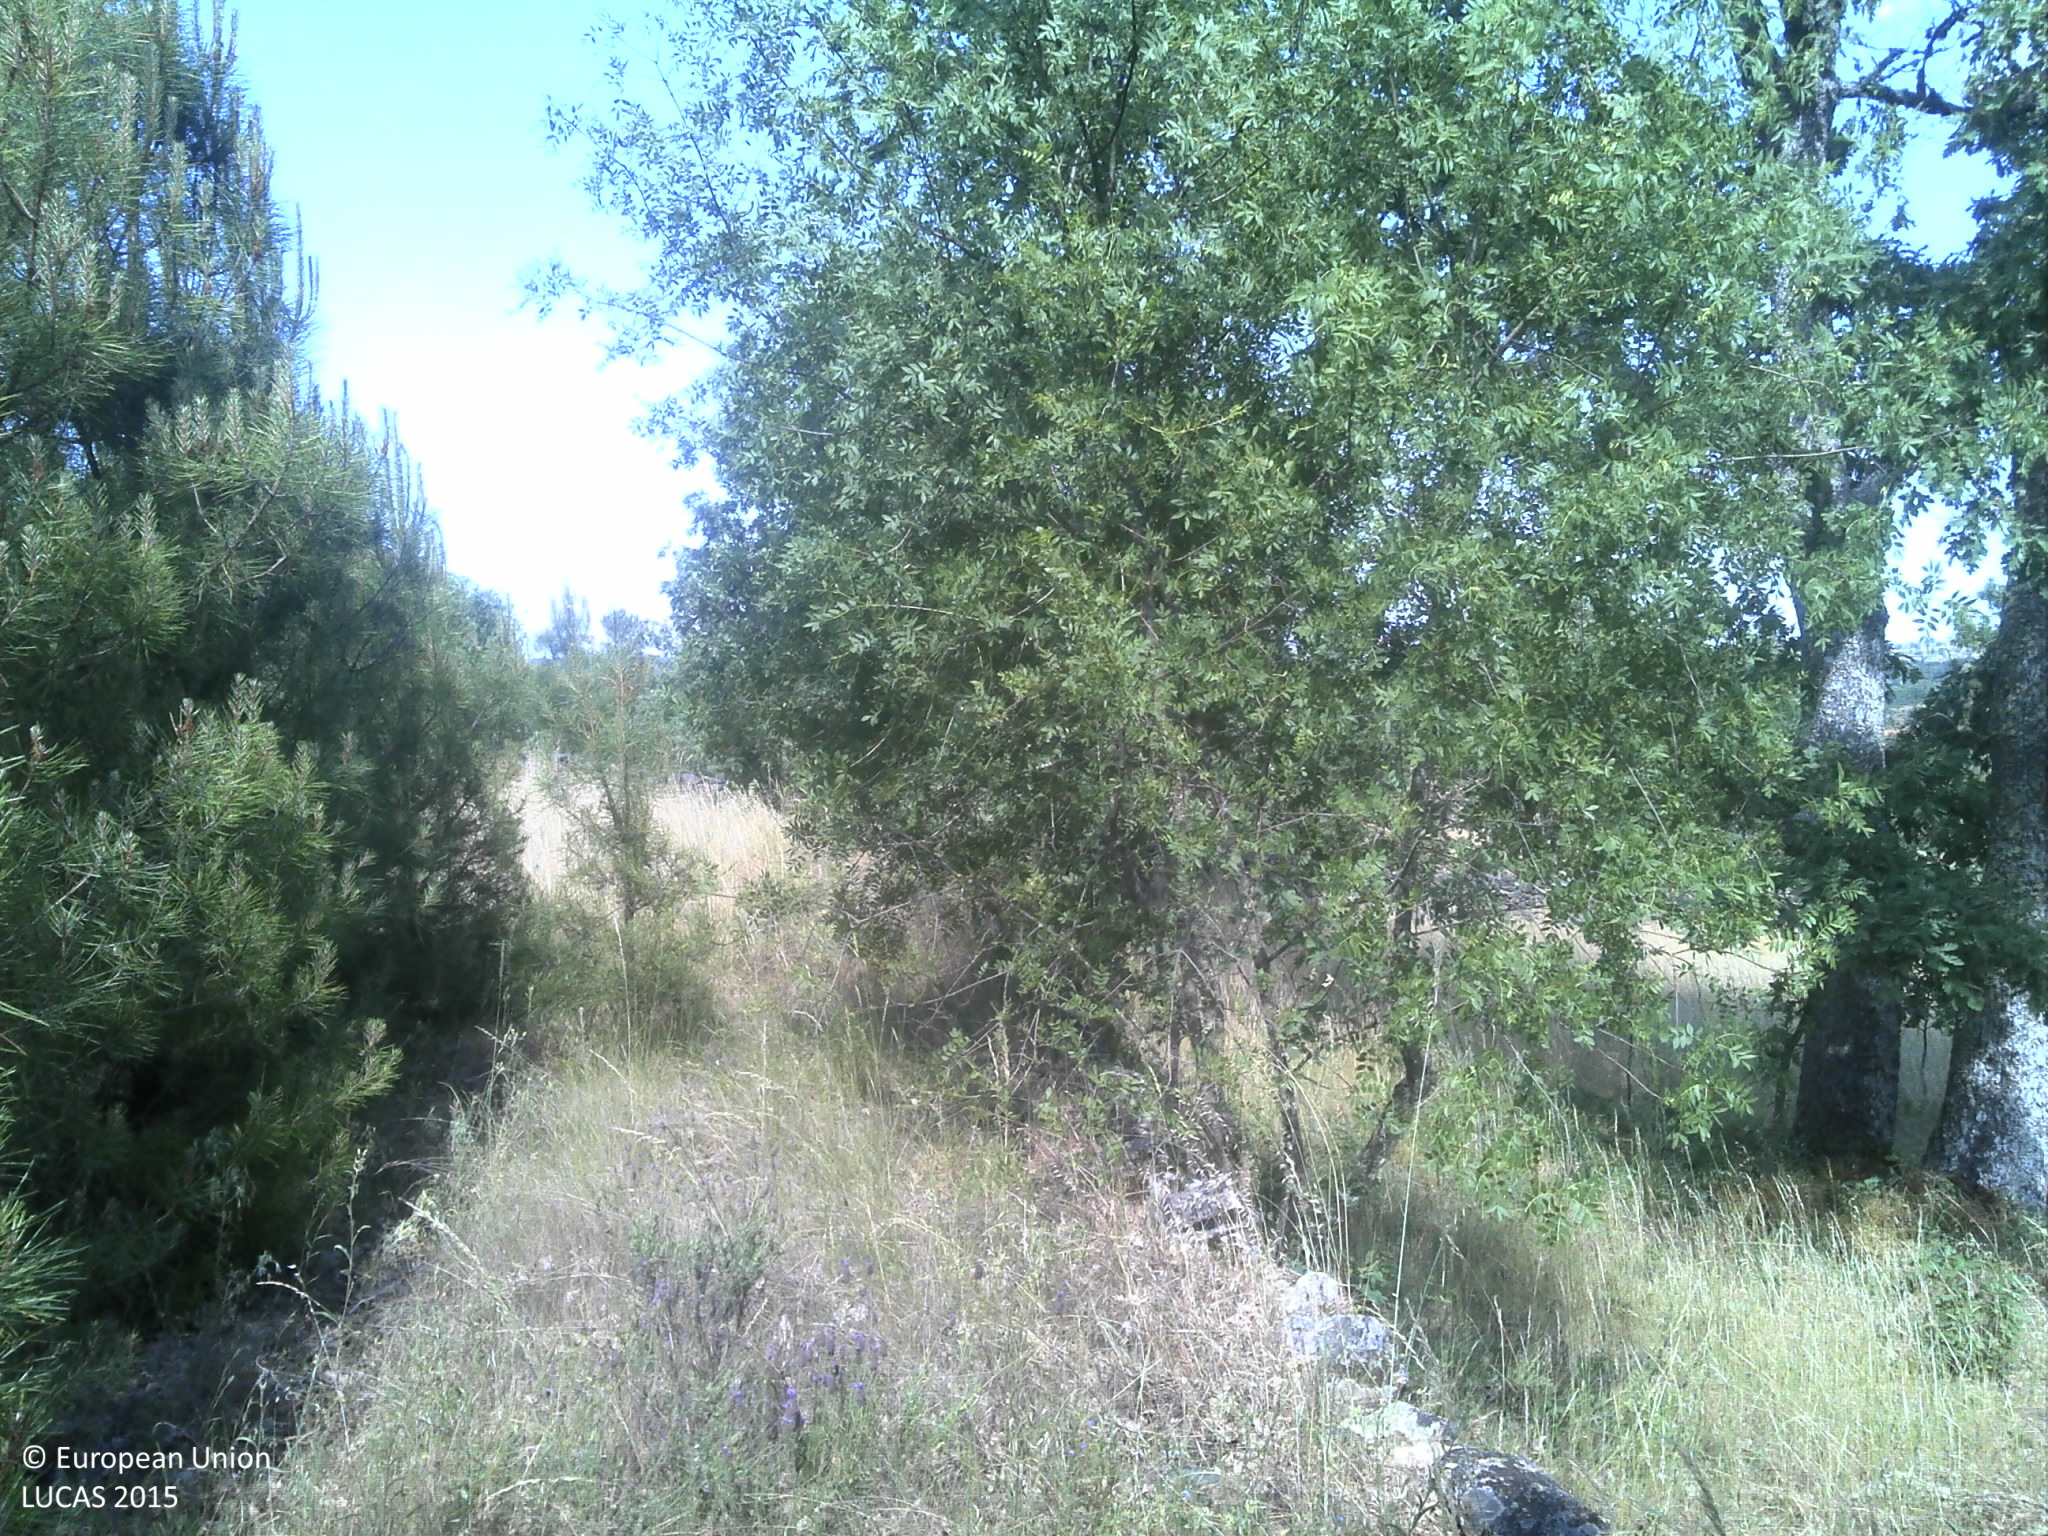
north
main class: Woodland
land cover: Pine dominated coniferous woodland
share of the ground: 50 - 75 %
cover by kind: coniferous forest trees 65 %, unconsolidated bare surface 15 %, shrubs 10 %, herbaceous plants 10 %
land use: Forestry
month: June
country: PT
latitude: 40.4244
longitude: -7.0357
